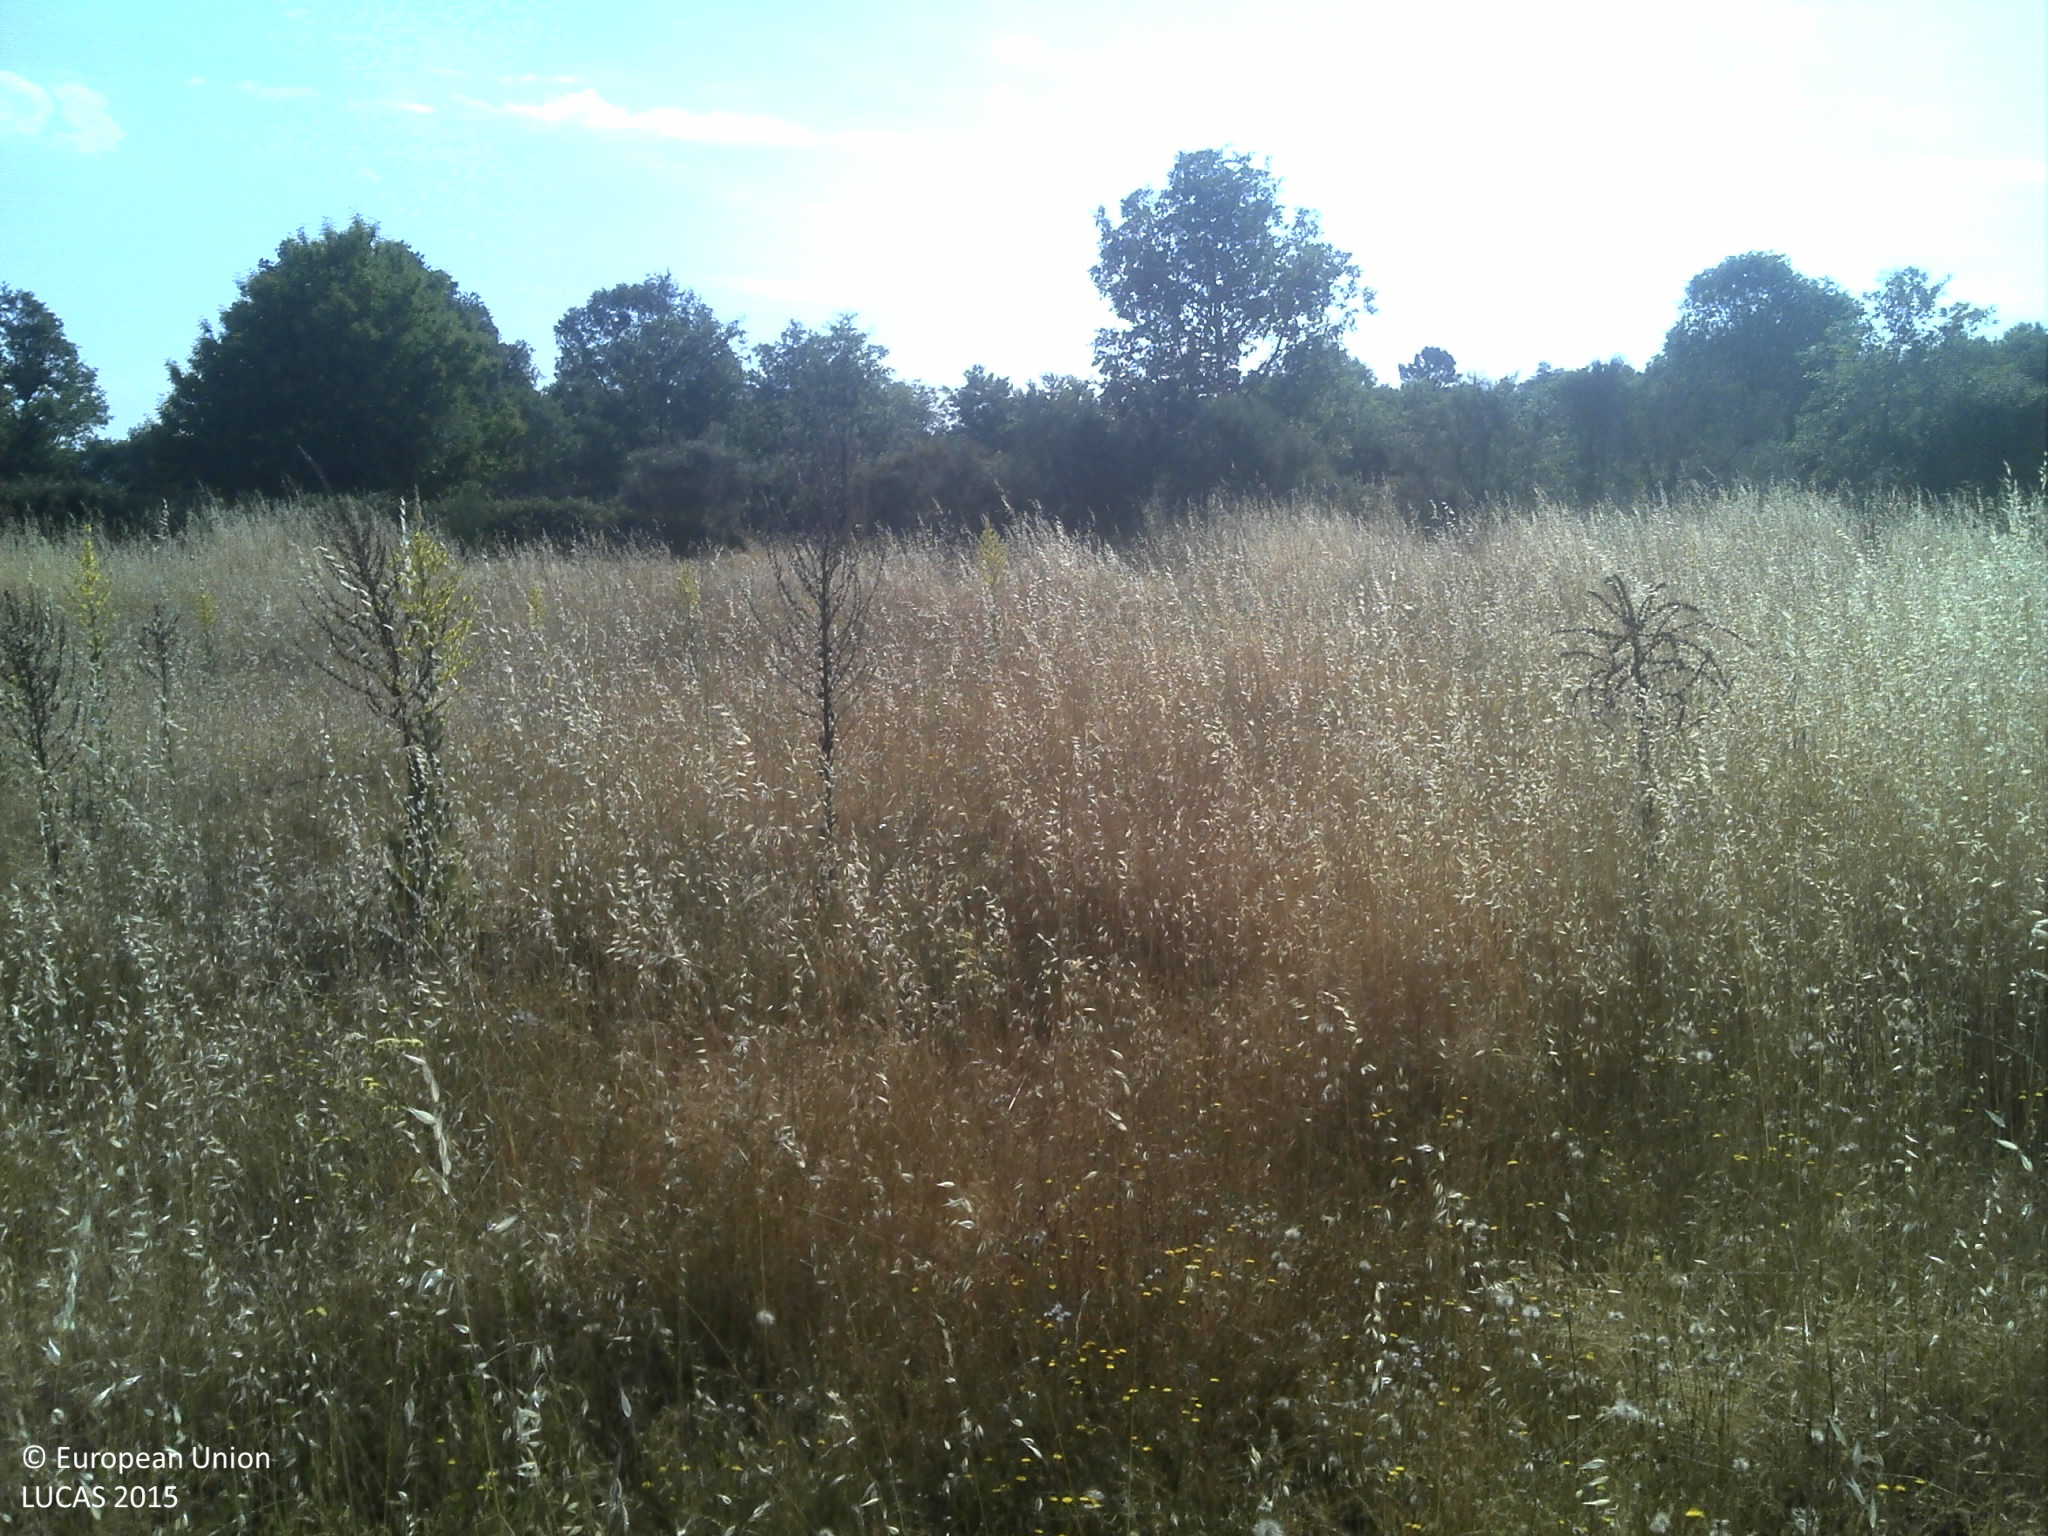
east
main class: Shrubland
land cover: Shrubland with sparse tree cover
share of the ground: > 75 %
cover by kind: shrubs 85 %, broadleaved forest trees 5 %, unconsolidated bare surface 5 %
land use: Abandoned areas
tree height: < 5 m
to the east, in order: Shrubland with sparse tree cover; Dry stone walls; Grassland without tree/shrub cover; Fences; Grass margins; Tracks; Dry stone walls; Fences; Grassland without tree/shrub cover; Dry stone walls; Tracks; Shruby margins; Grassland without tree/shrub cover; Shrubland with sparse tree cover; Tracks; Shrubland with sparse tree cover
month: June
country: PT
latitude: 40.3581
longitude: -6.9935
